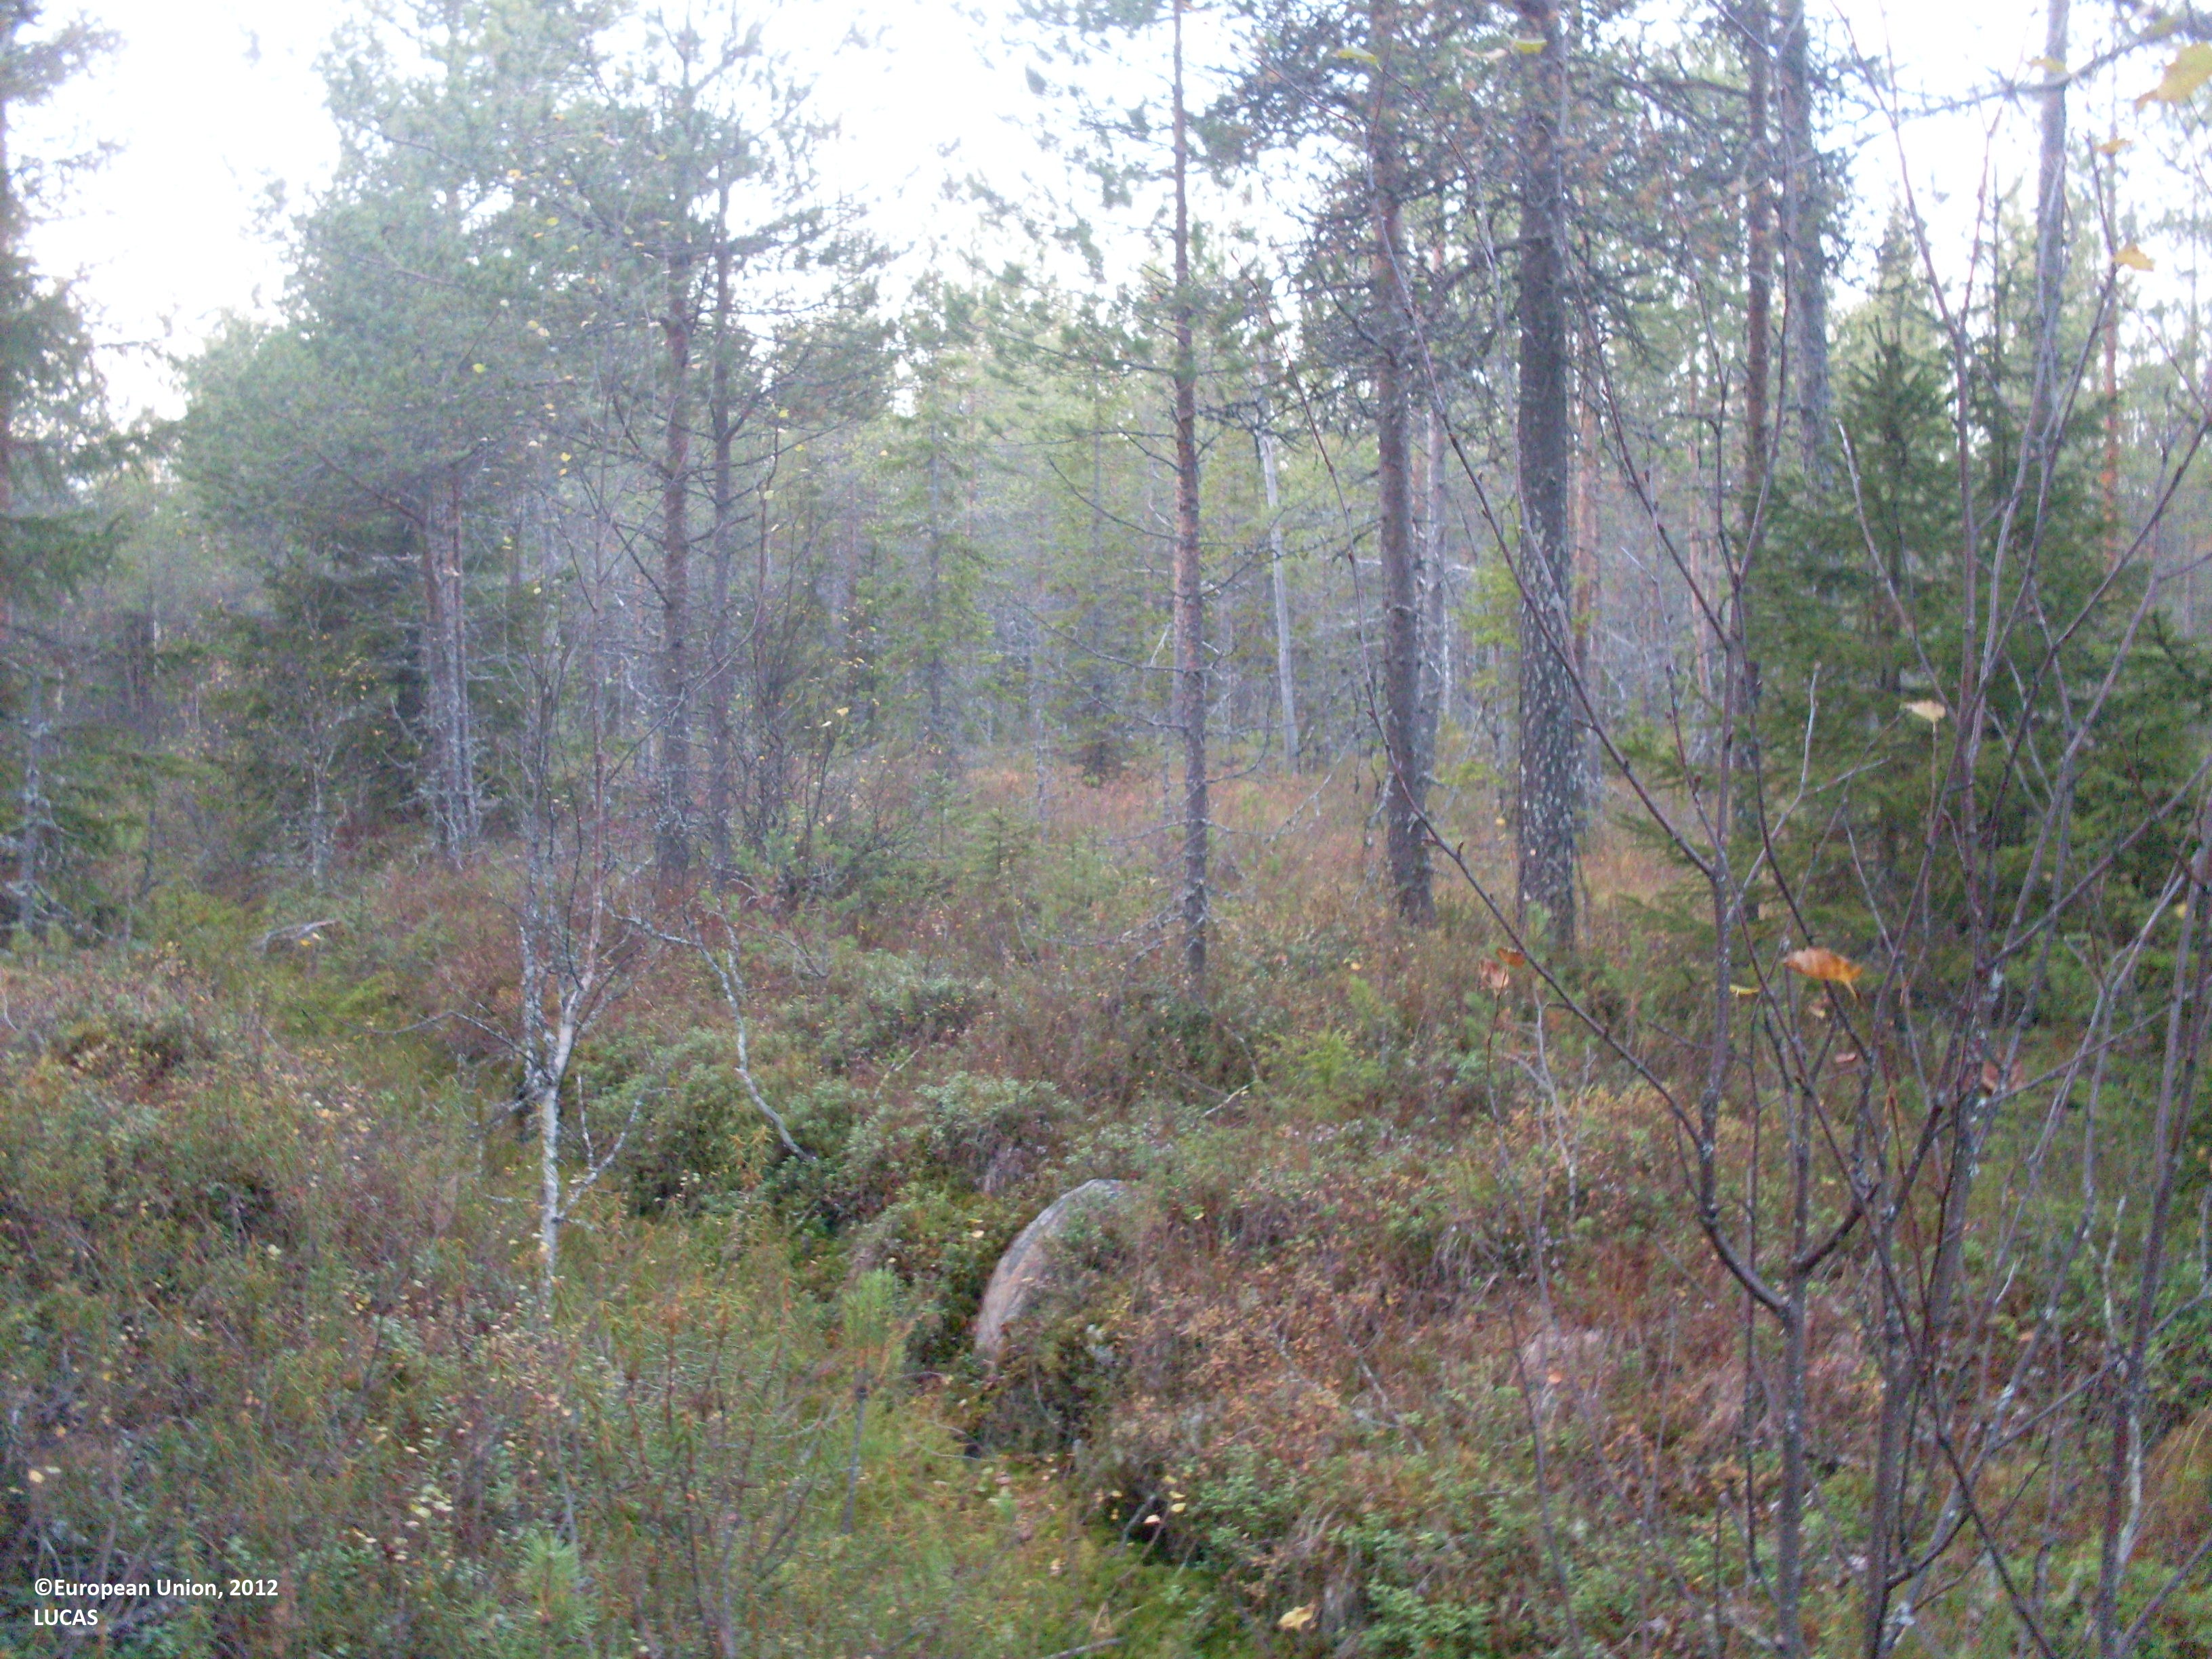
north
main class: Woodland
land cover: Pine dominated mixed woodland
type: boreal forest
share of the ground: 50 - 75 %
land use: Forestry
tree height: > 5 m
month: September
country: FI
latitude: 64.6180
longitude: 29.5979
